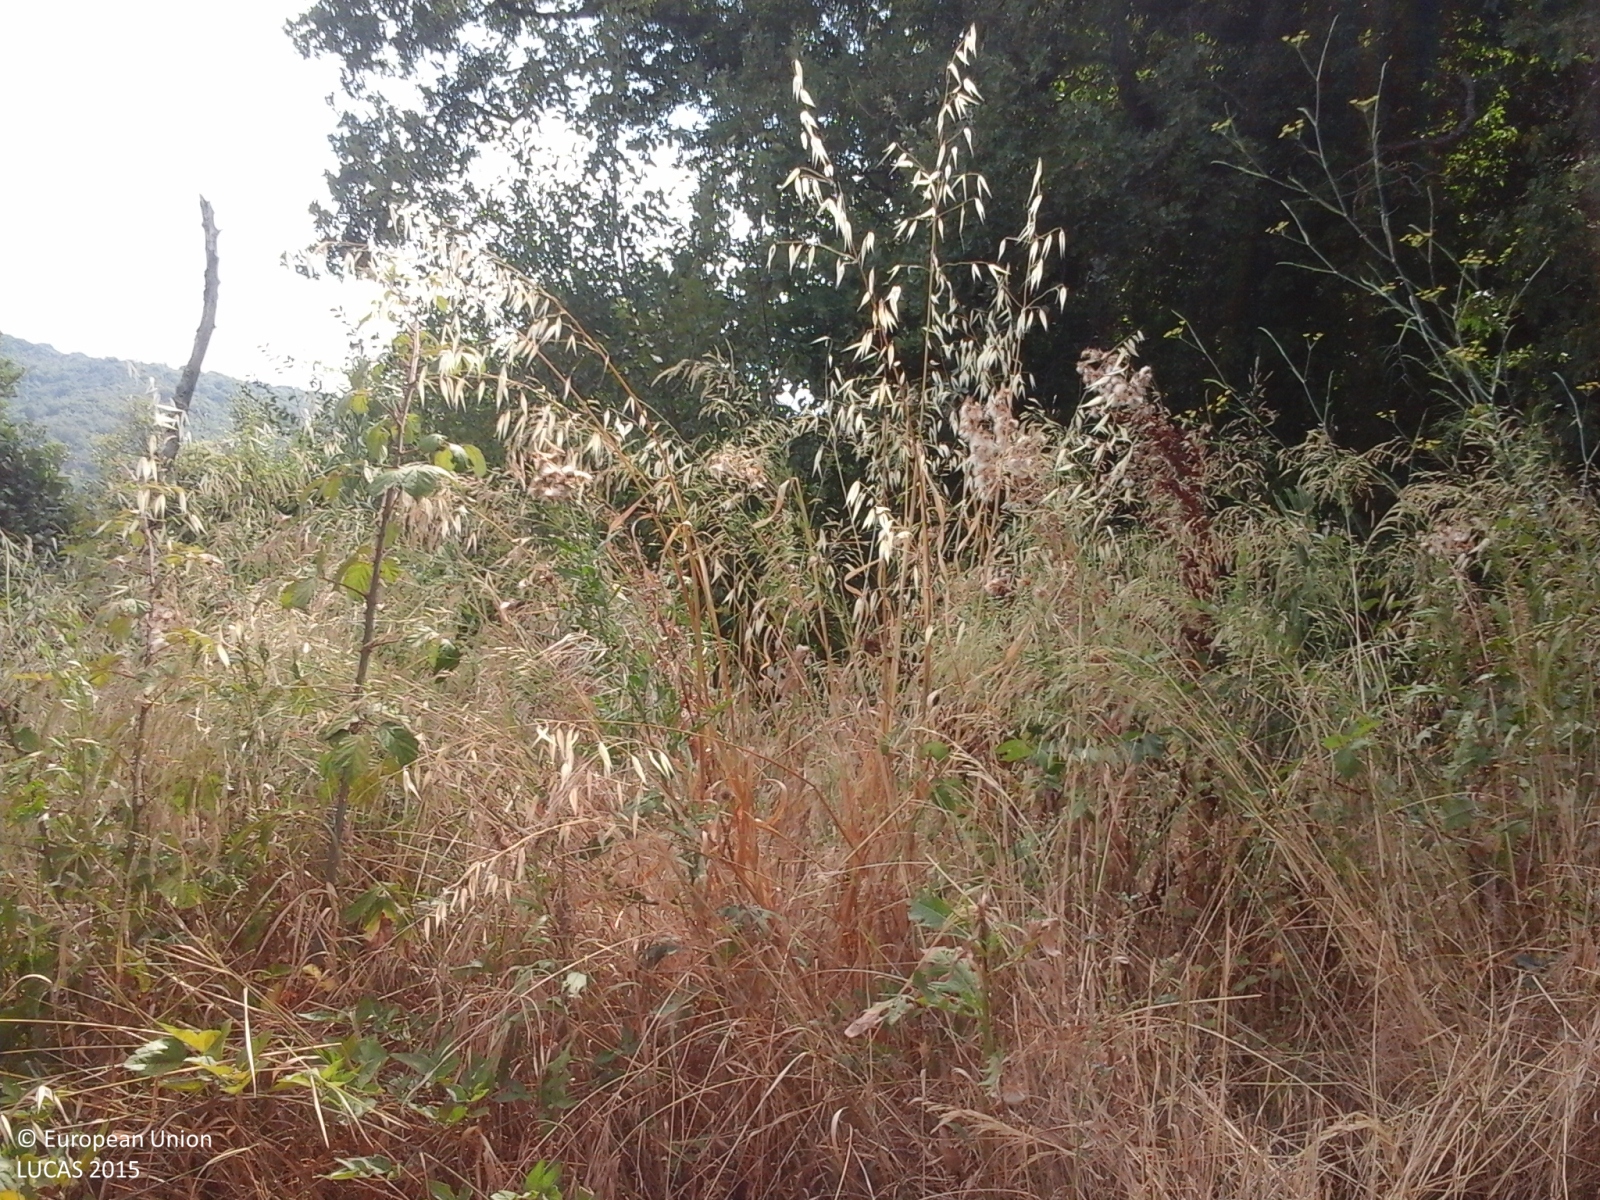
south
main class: Woodland
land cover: Broadleaved woodland
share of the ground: > 75 %
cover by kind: broadleaved forest trees 100 %
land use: Forestry
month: August
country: IT
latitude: 43.1922
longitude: 10.8465
